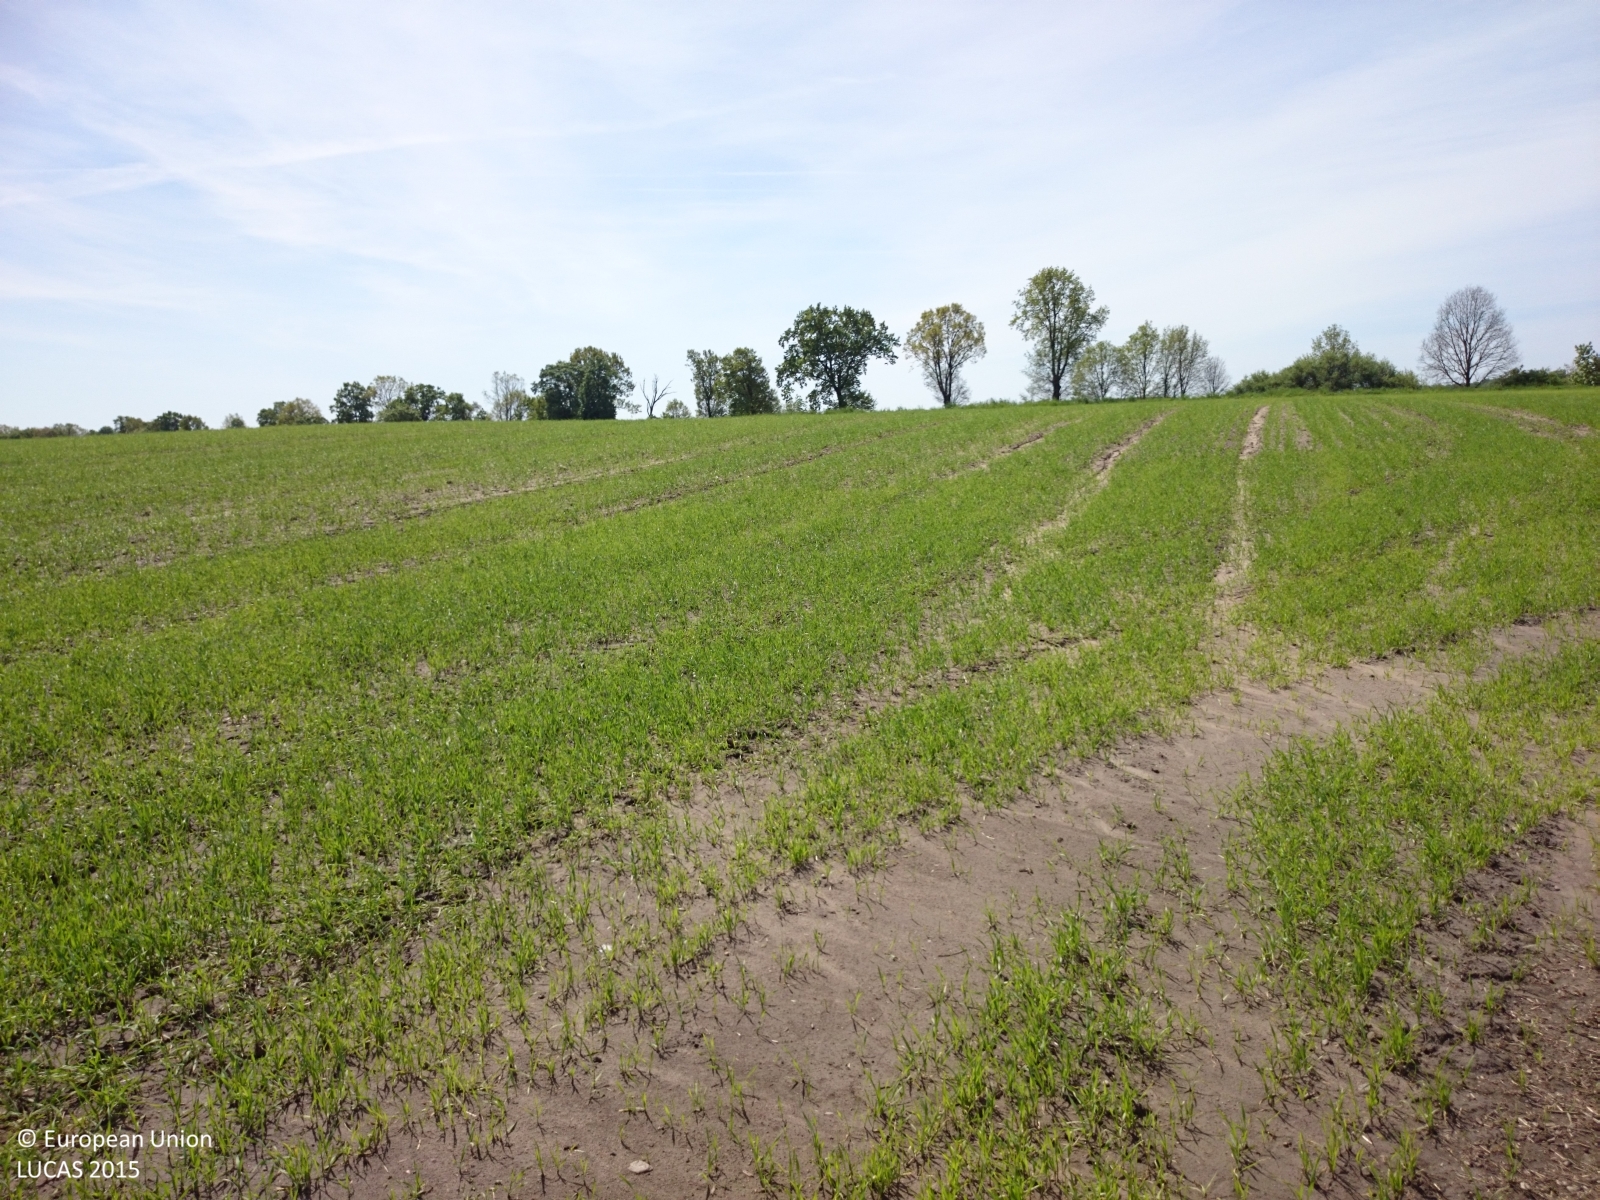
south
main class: Cropland
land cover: Rye
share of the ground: 10 - 25 %
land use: Agriculture (excluding fallow land and kitchen gardens)
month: May
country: PL
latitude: 52.4483
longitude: 16.2302
